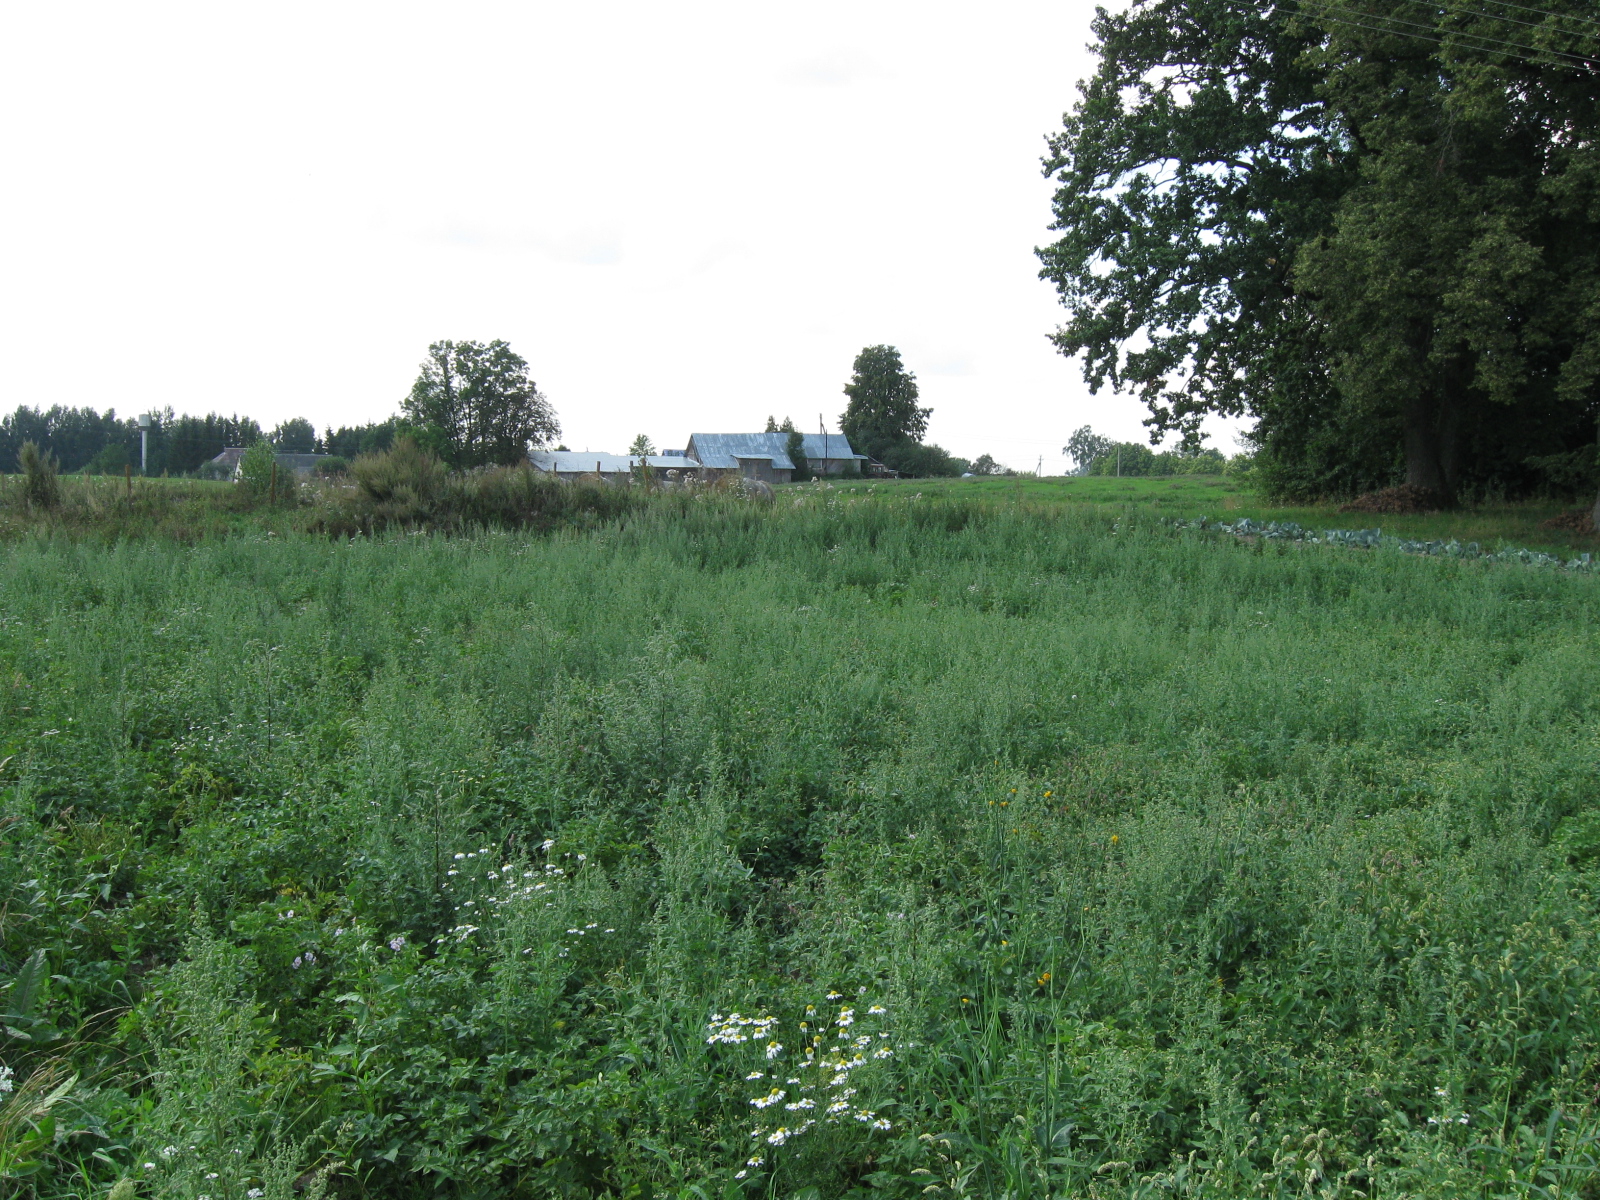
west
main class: Cropland
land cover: Potatoes
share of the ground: > 75 %
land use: Kitchen garden
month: August
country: LT
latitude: 54.7386
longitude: 23.6754
